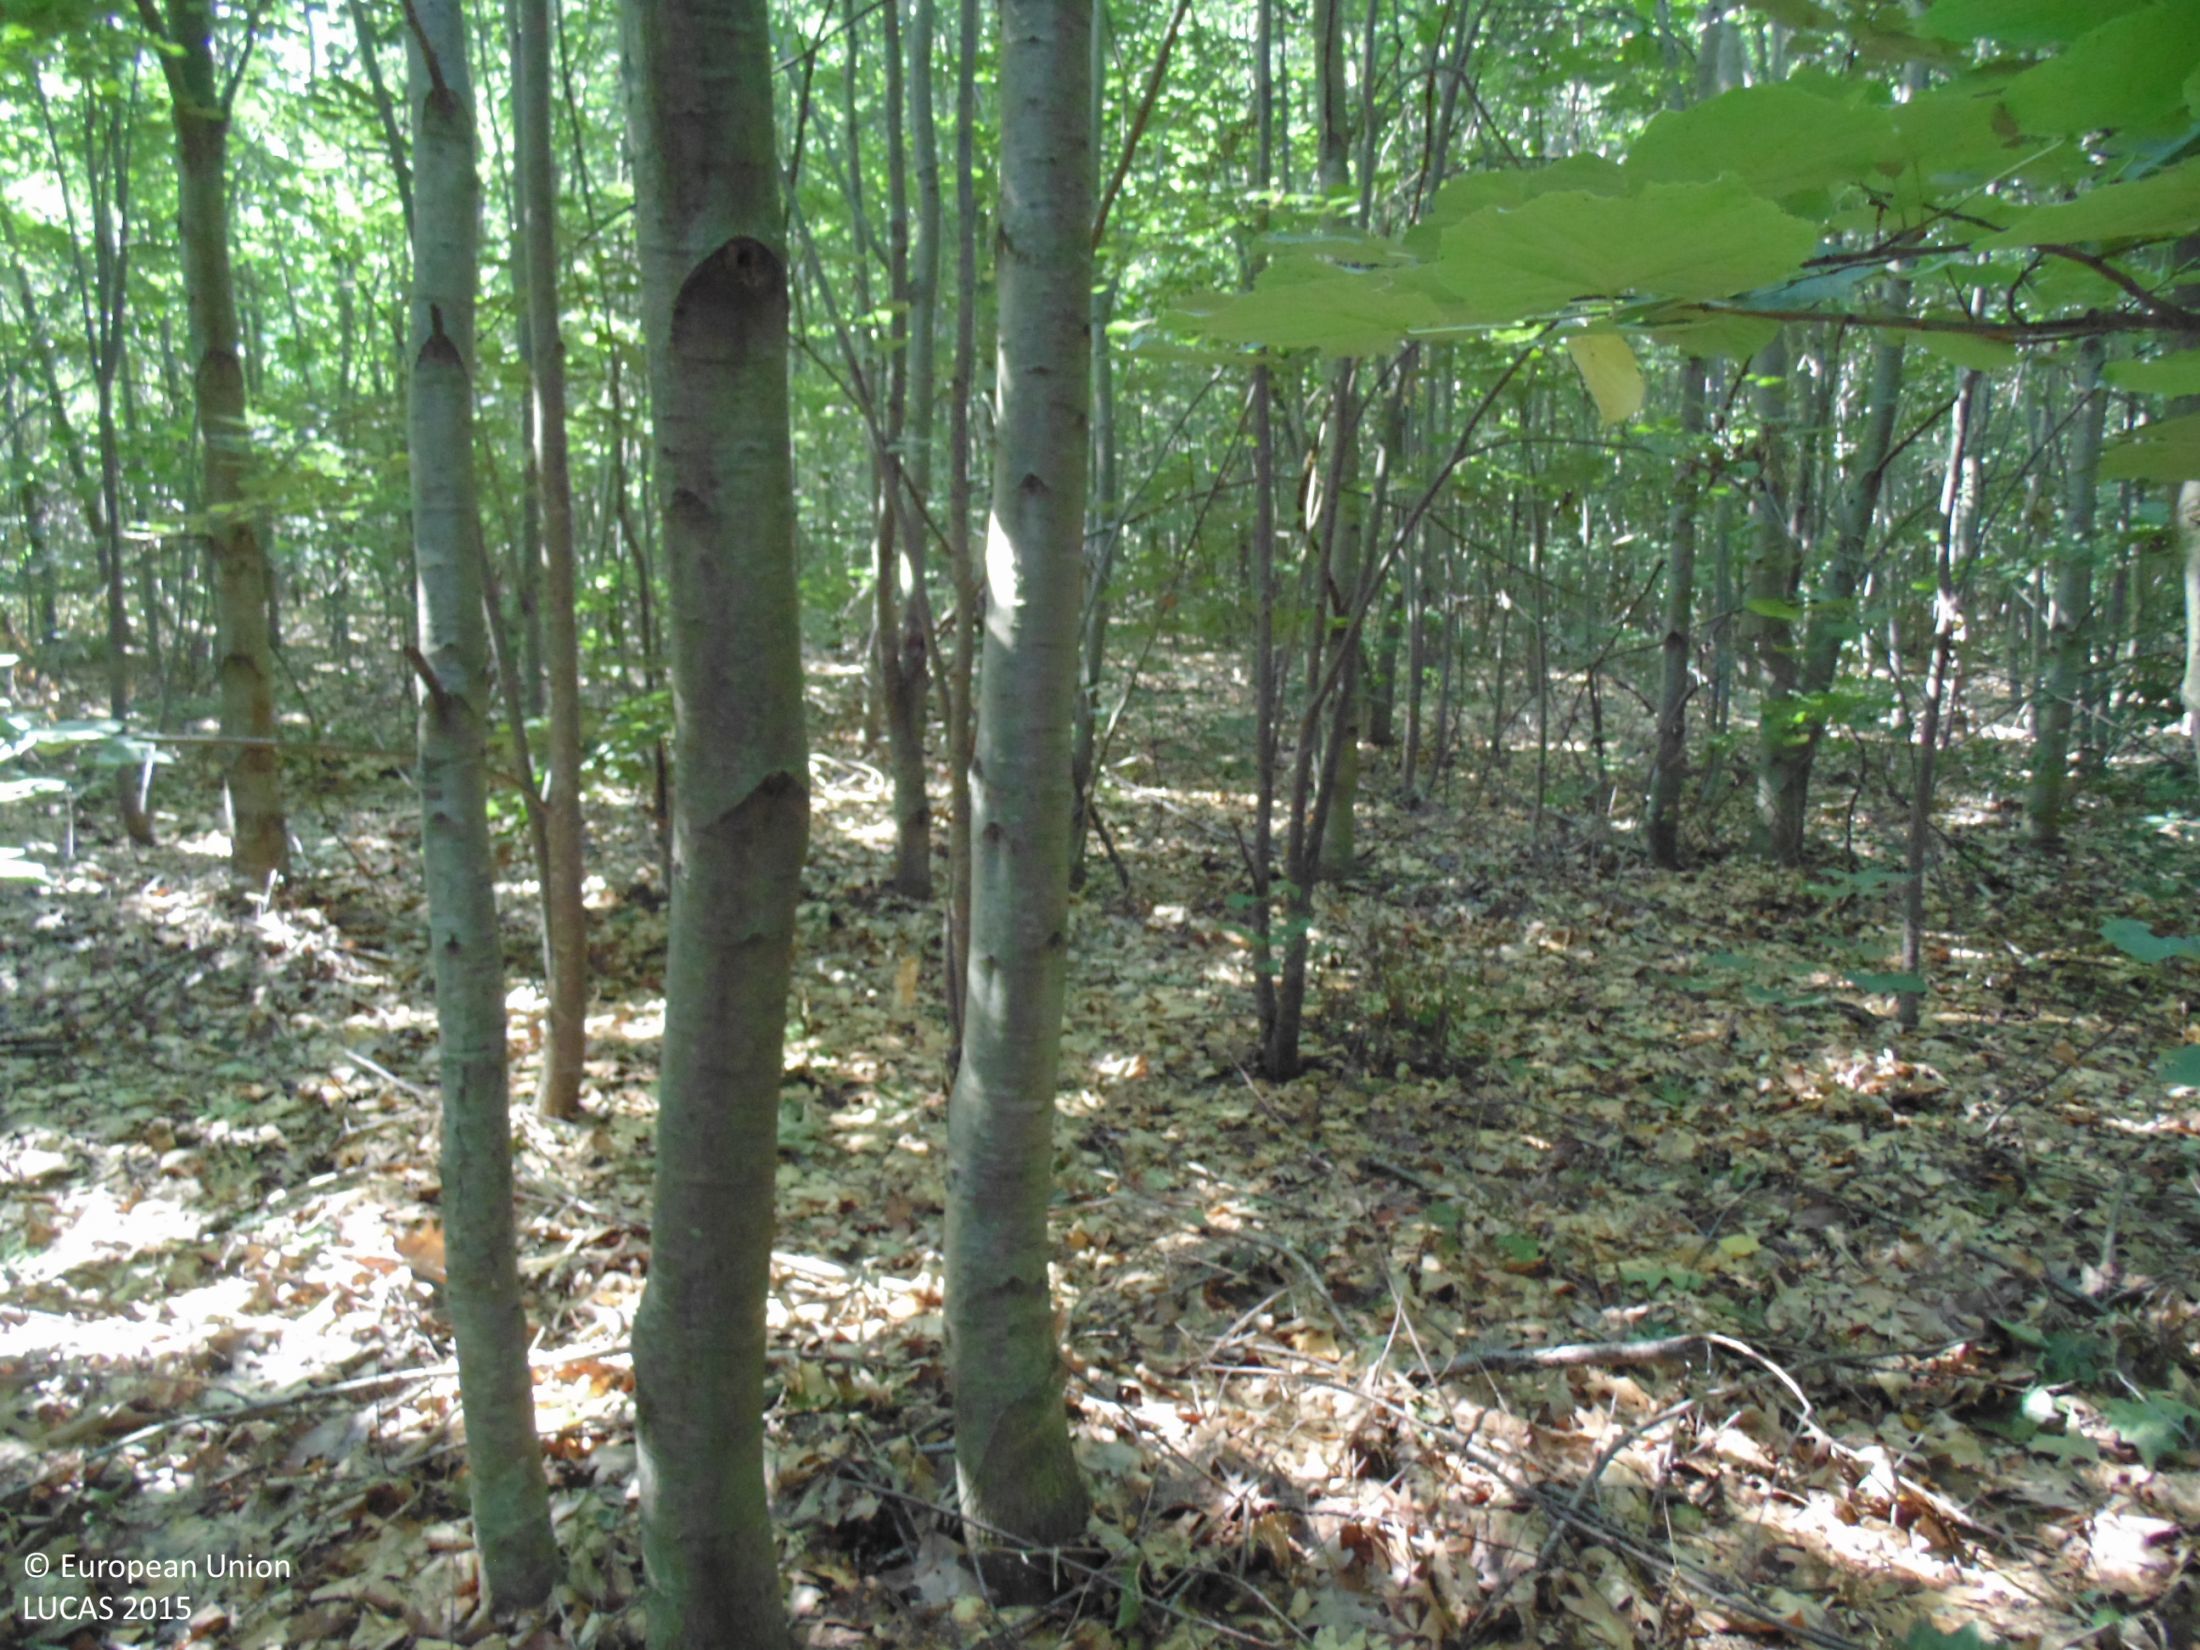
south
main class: Woodland
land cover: Broadleaved woodland
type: mesophytic deciduous forest
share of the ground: > 75 %
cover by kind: broadleaved forest trees 90 %, shrubs 5 %, unconsolidated bare surface 5 %
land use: Forestry
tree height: > 5 m
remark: Clear cut
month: August
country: BG
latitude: 43.6897
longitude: 27.5407
